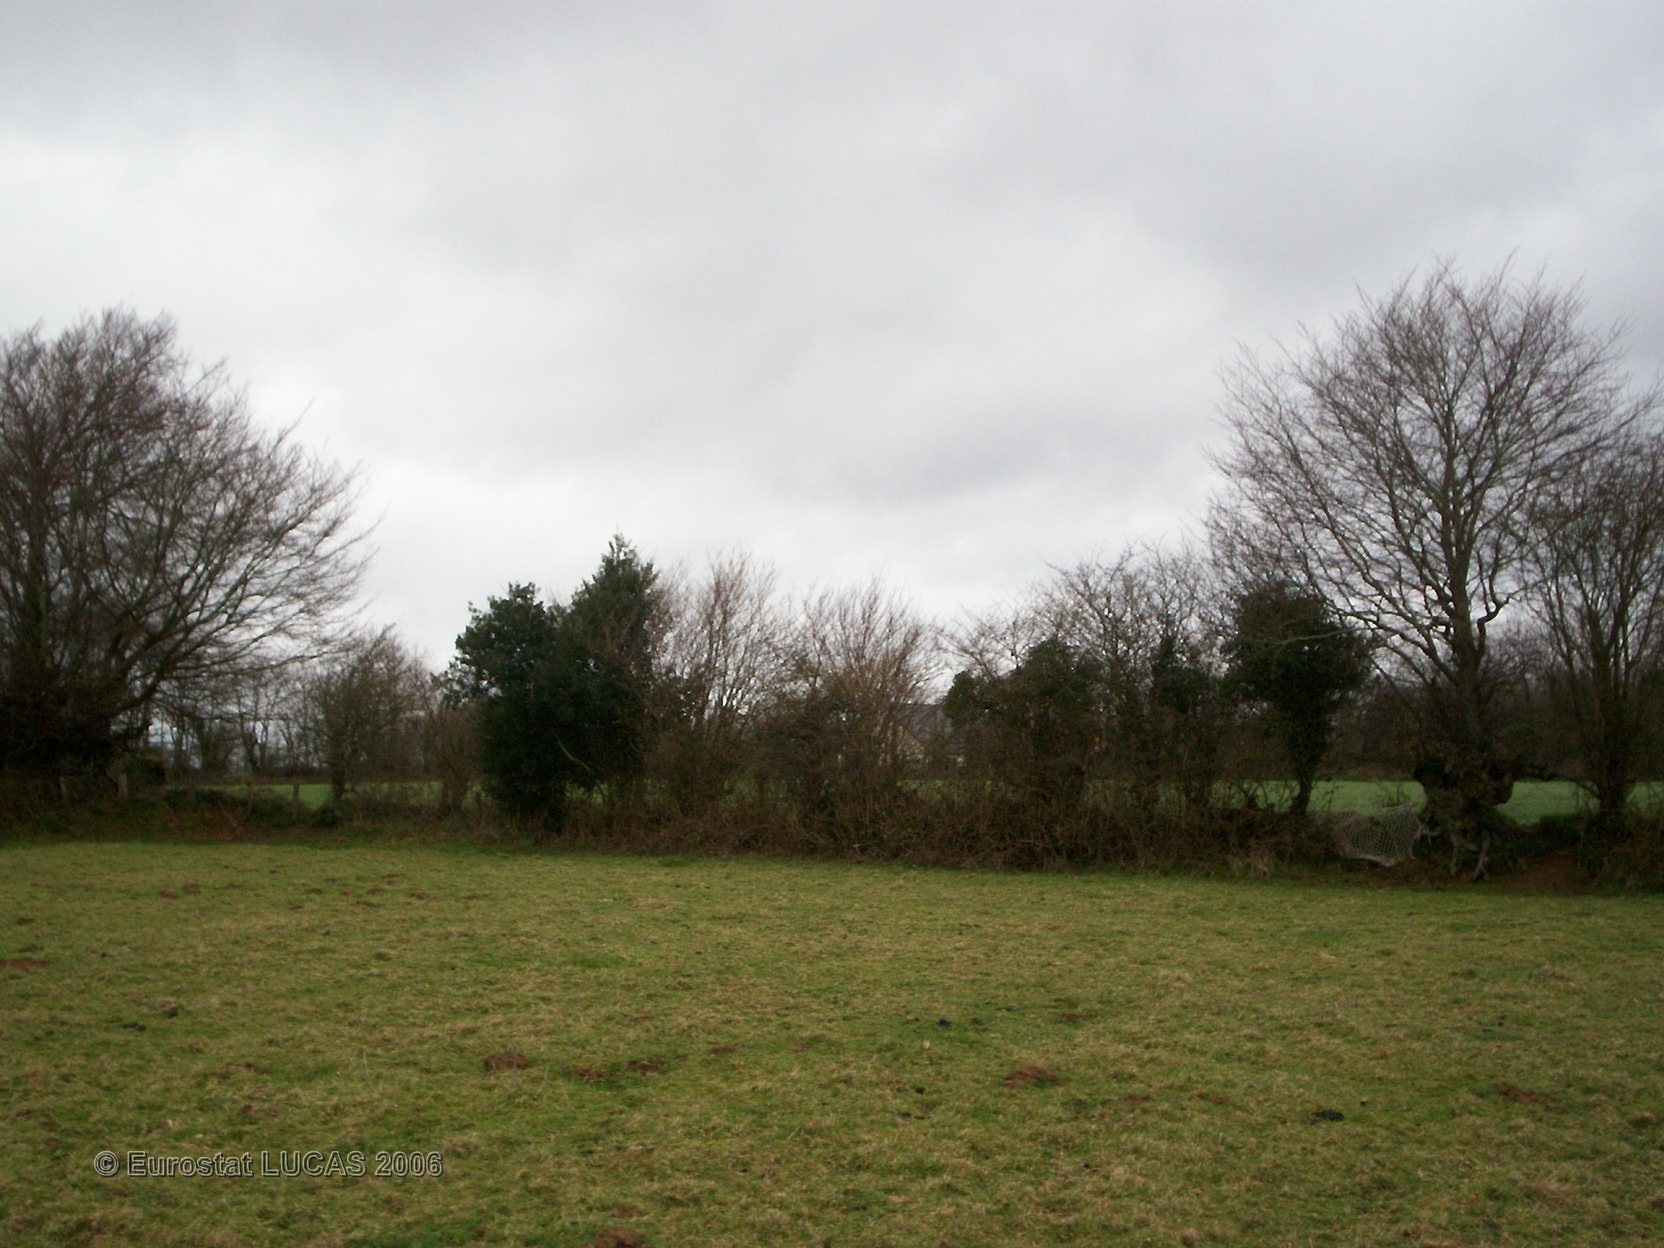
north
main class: Grassland
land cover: Grassland without tree/shrub cover
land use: Agriculture (excluding fallow land and kitchen gardens)
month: April
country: FR
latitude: 49.5719
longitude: -1.5975
